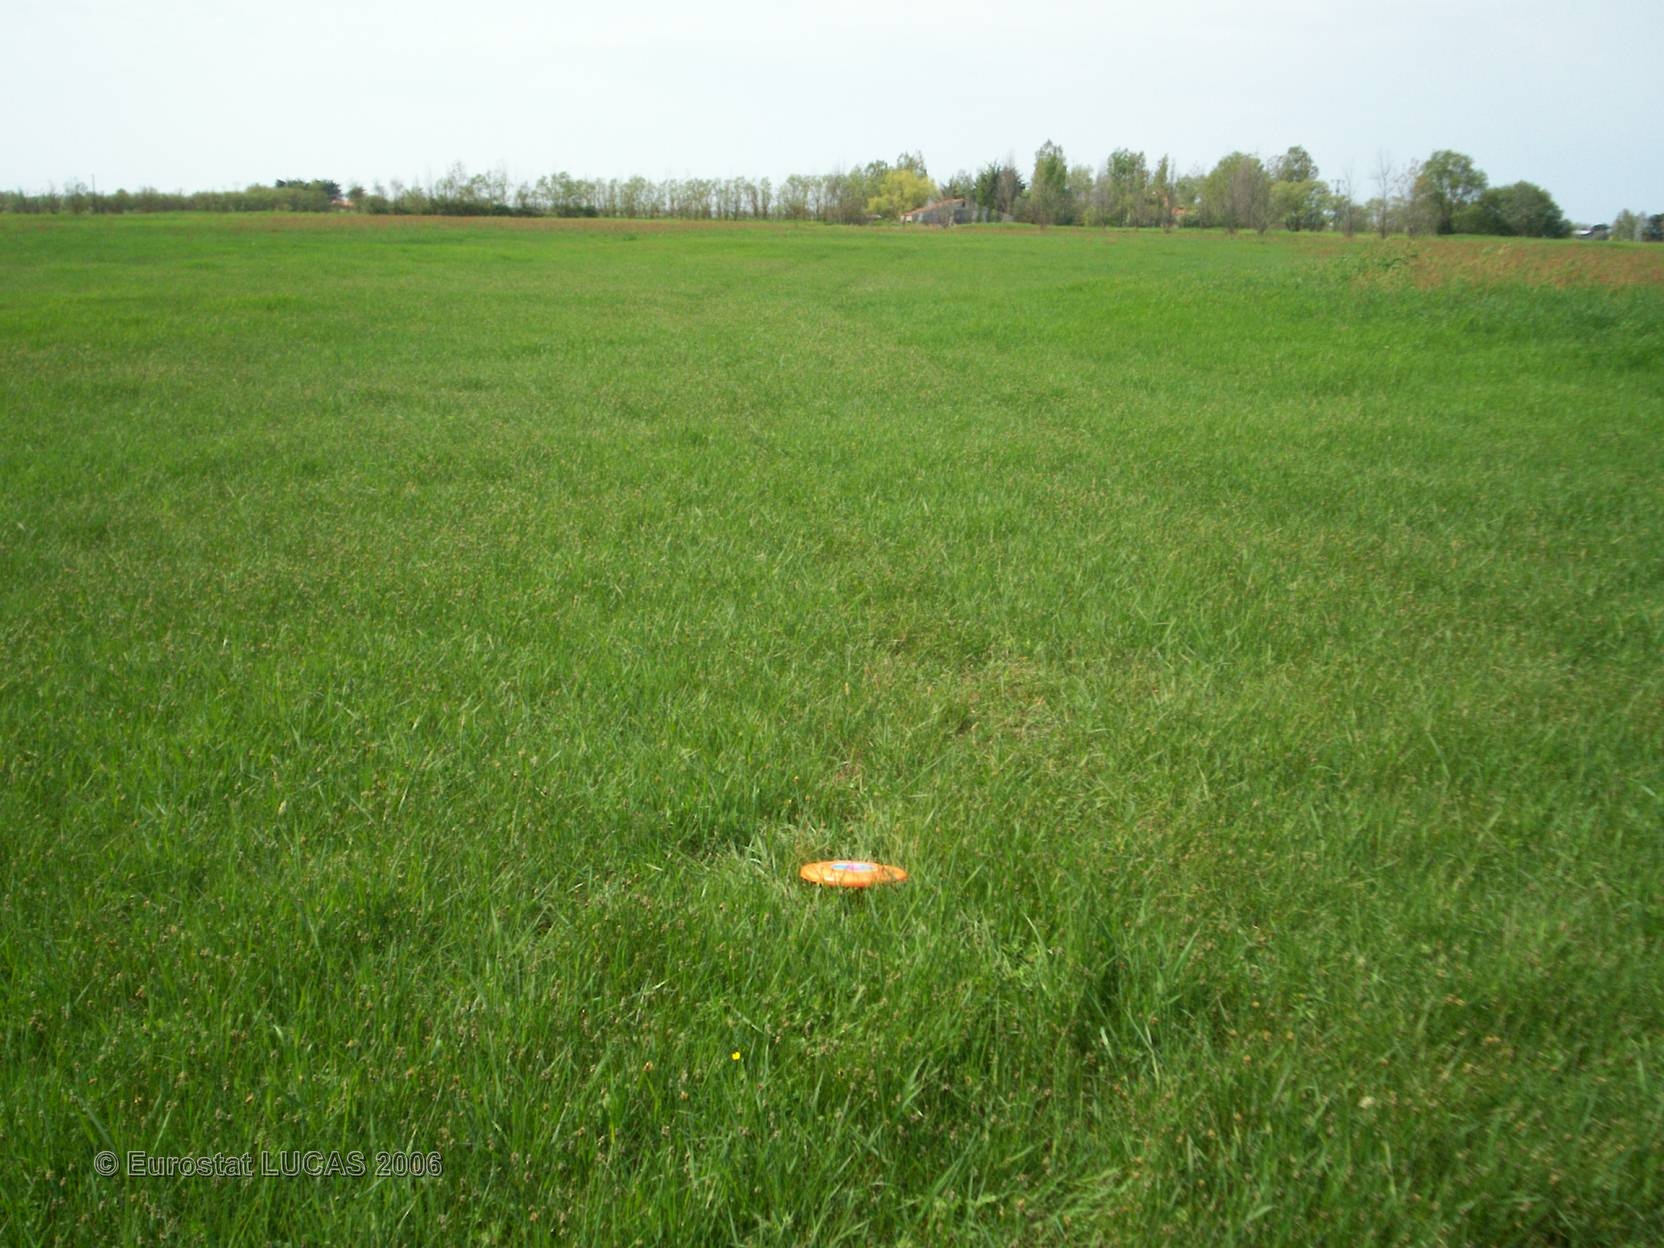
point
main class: Grassland
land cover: Grassland without tree/shrub cover
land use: Agriculture (excluding fallow land and kitchen gardens)
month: May
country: FR
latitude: 46.8476
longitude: -2.0727
